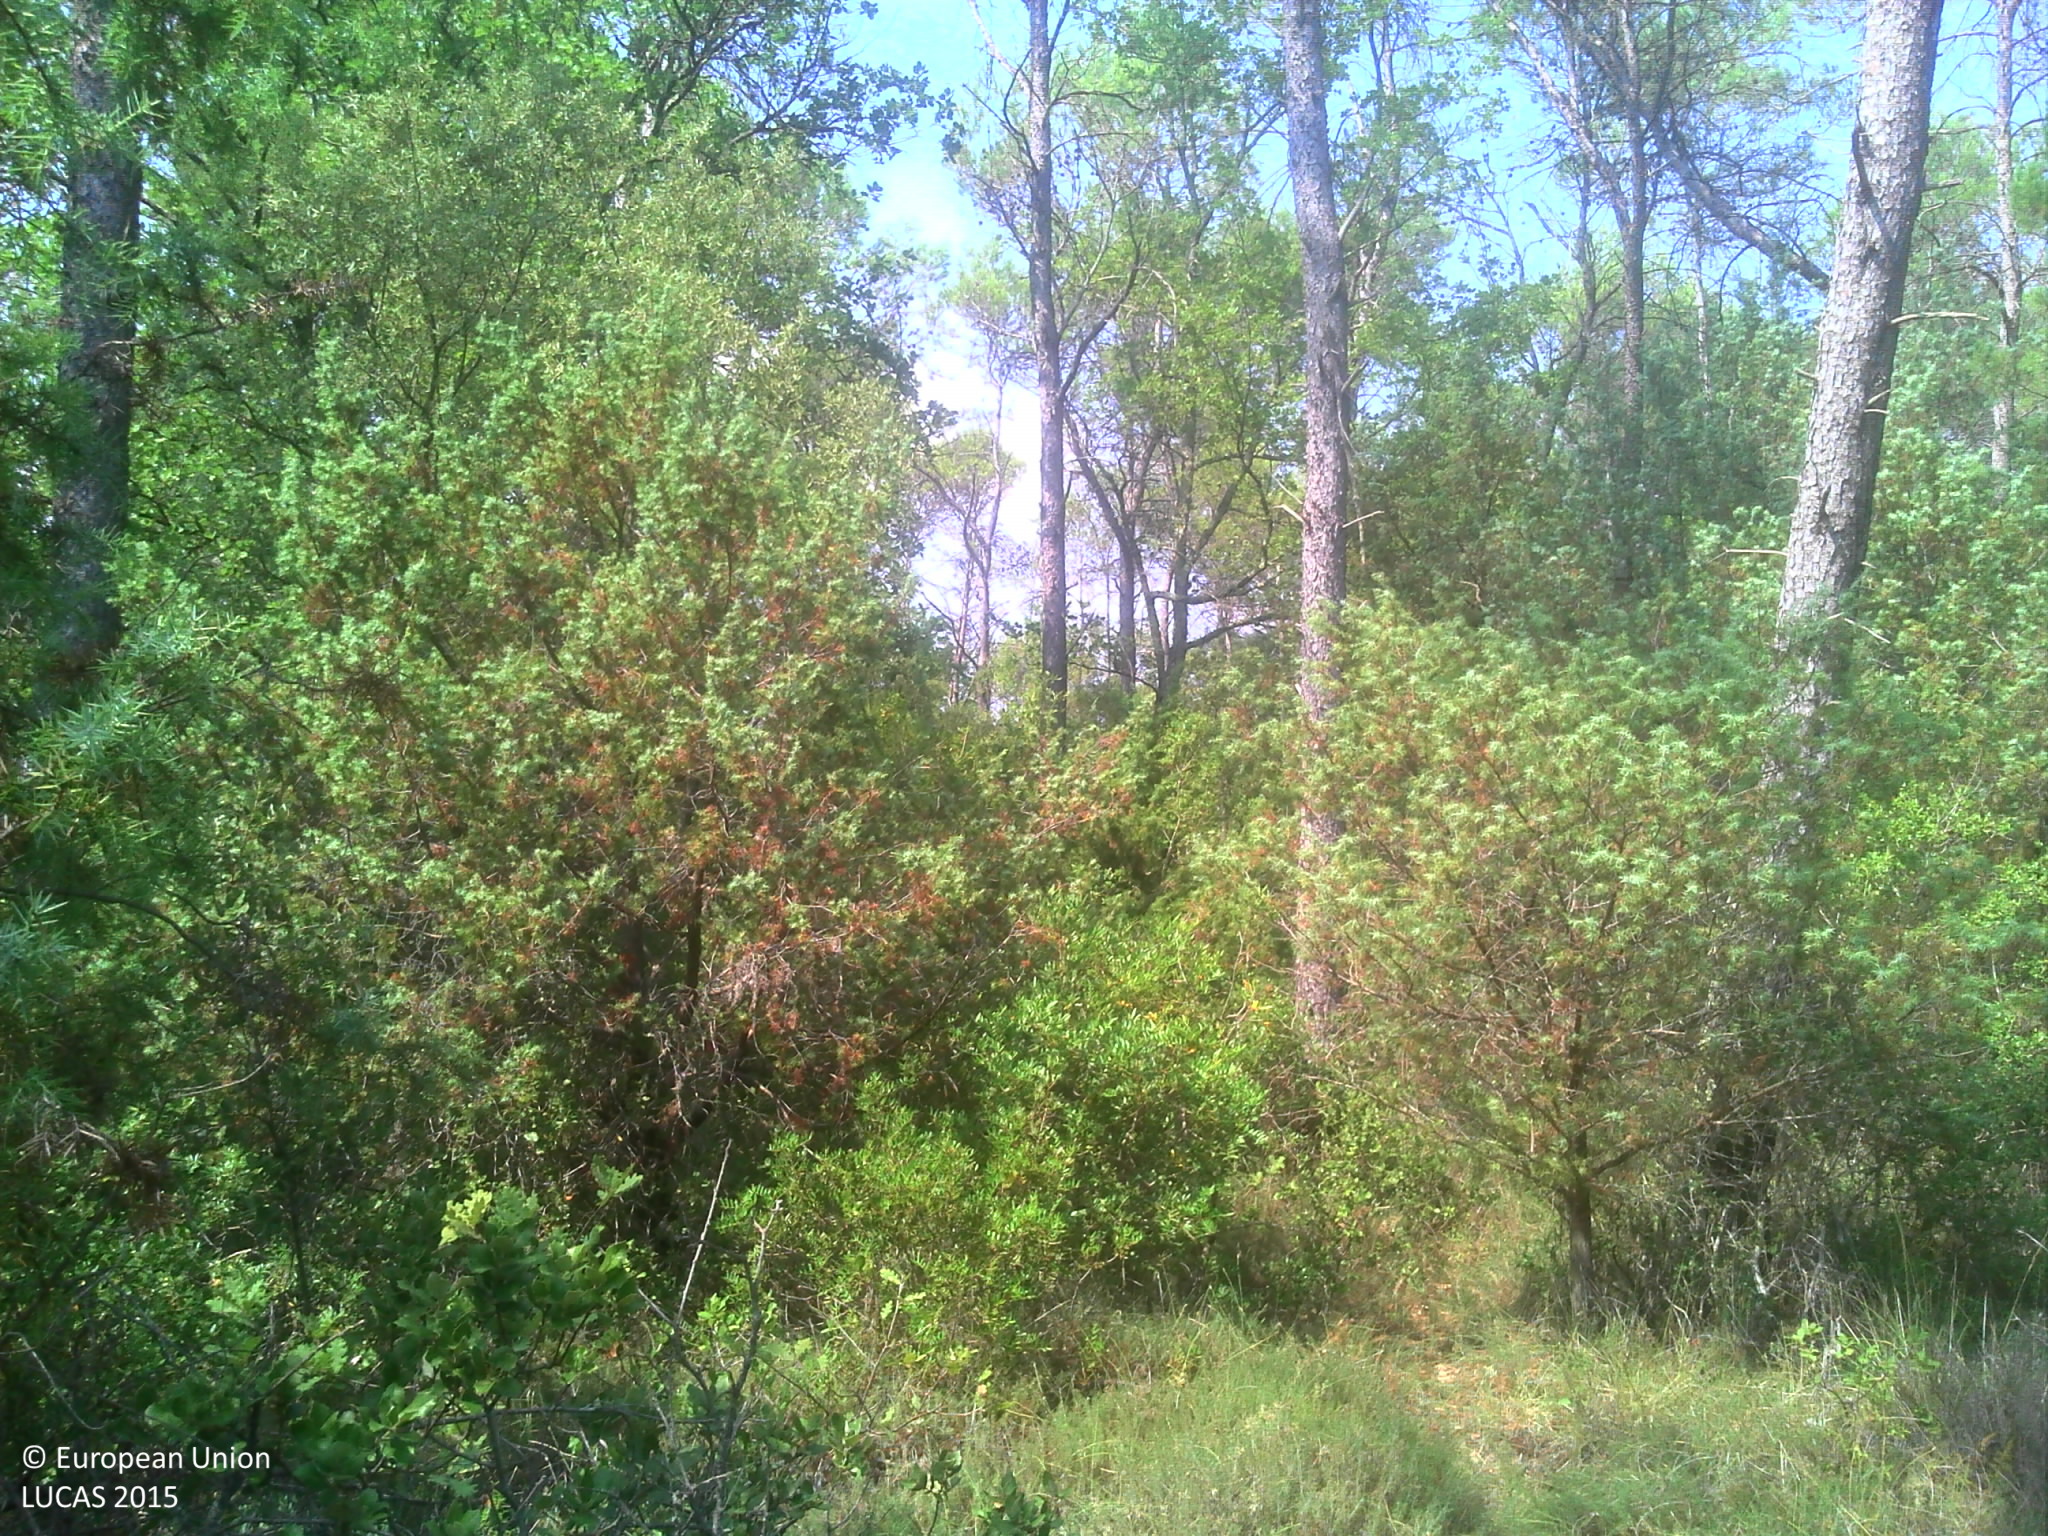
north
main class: Woodland
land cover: Pine dominated mixed woodland
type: coniferous forest of the mediterranean region
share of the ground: > 75 %
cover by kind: broadleaved forest trees 40 %, coniferous forest trees 35 %, shrubs 20 %, herbaceous plants 5 %
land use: Semi-natural and natural areas not in use
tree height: > 5 m
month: July
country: FR
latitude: 43.4561
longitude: 6.3630
